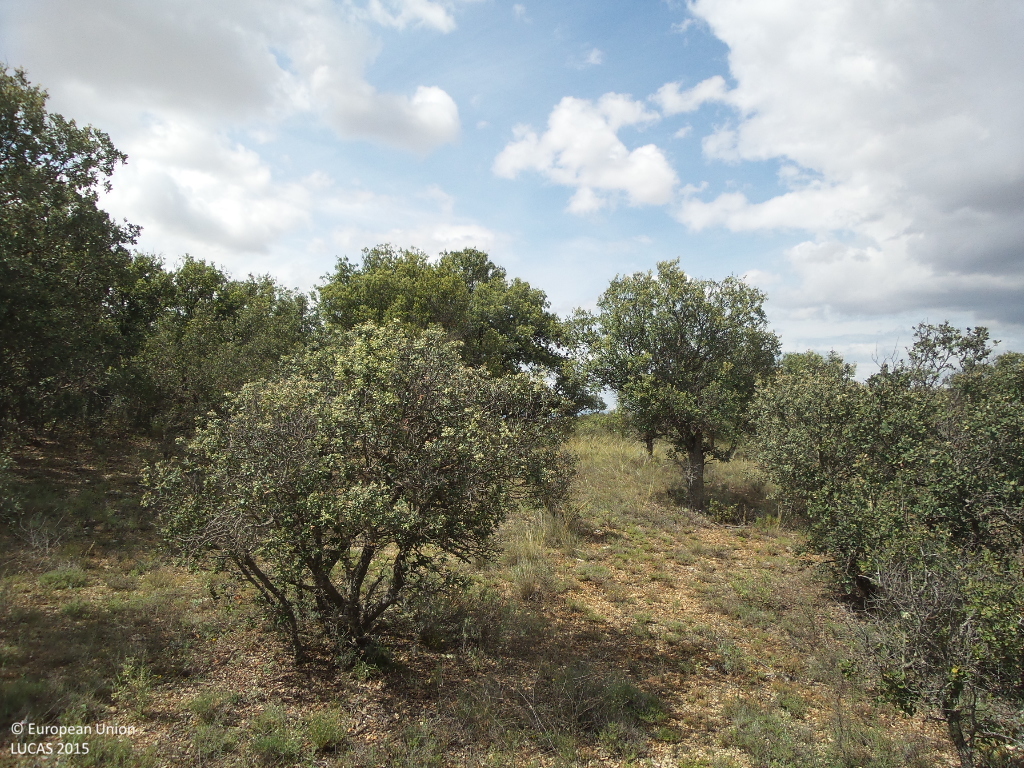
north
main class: Woodland
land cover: Broadleaved woodland
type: broadleaved evergreen forest
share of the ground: 50 - 75 %
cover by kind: broadleaved forest trees 65 %, unconsolidated bare surface 15 %, shrubs 10 %, herbaceous plants 10 %
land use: Forestry
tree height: < 5 m
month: June
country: ES
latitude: 41.5102
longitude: -3.2118
